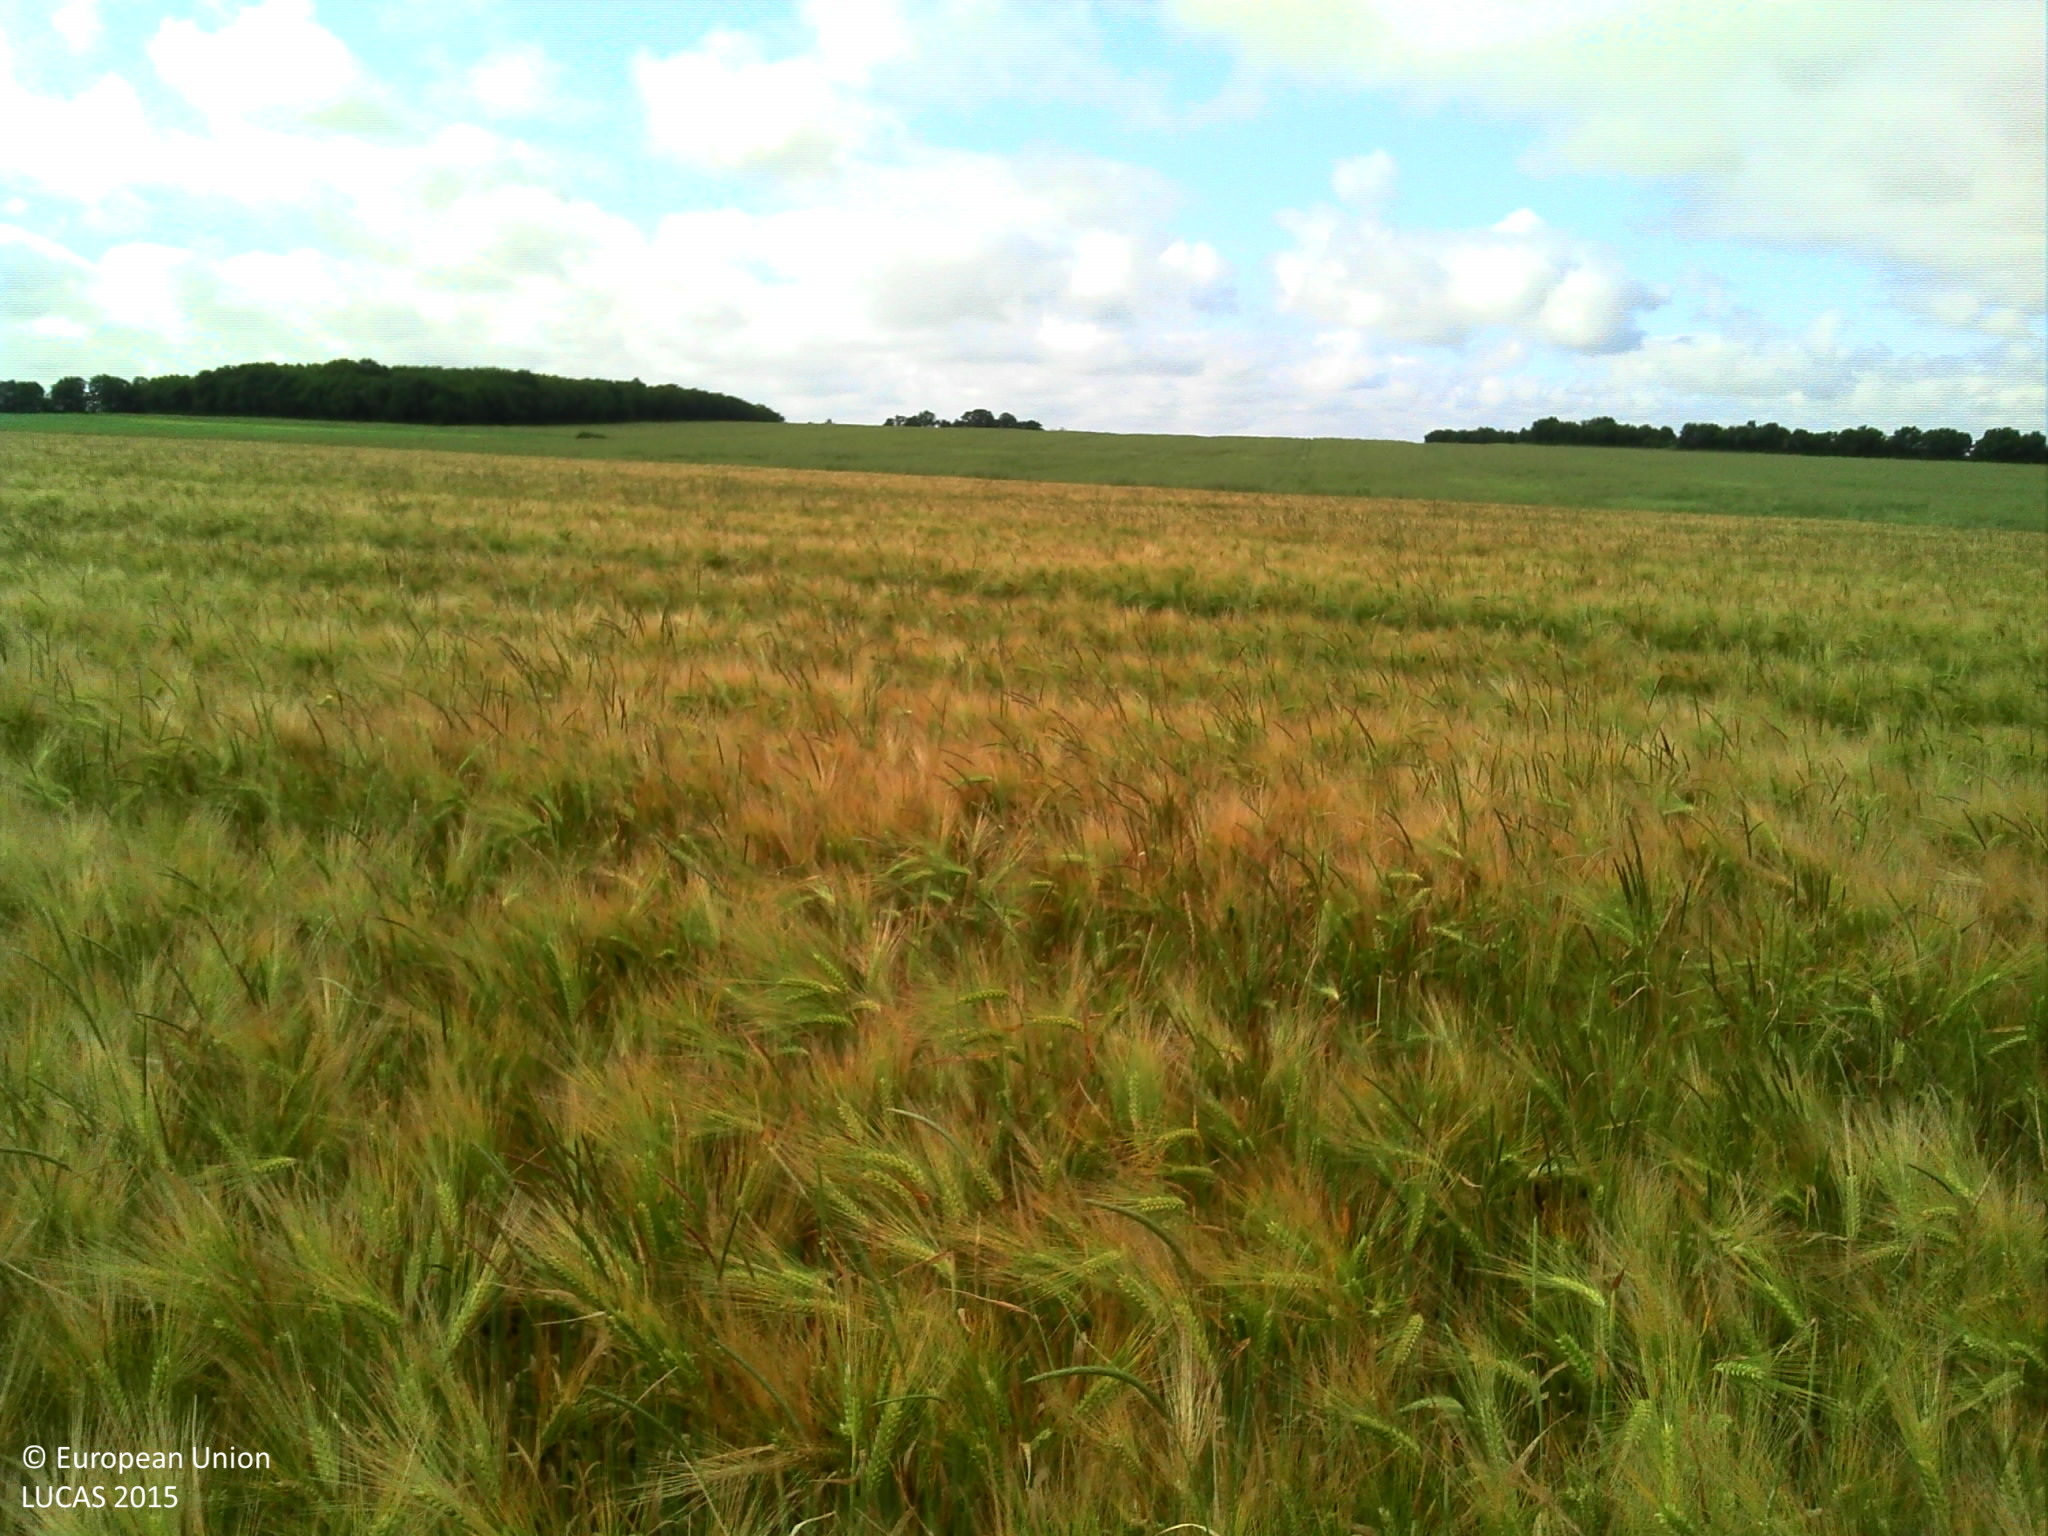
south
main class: Cropland
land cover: Barley
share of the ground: > 75 %
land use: Agriculture (excluding fallow land and kitchen gardens)
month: June
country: FR
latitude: 46.9174
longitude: 2.7334
